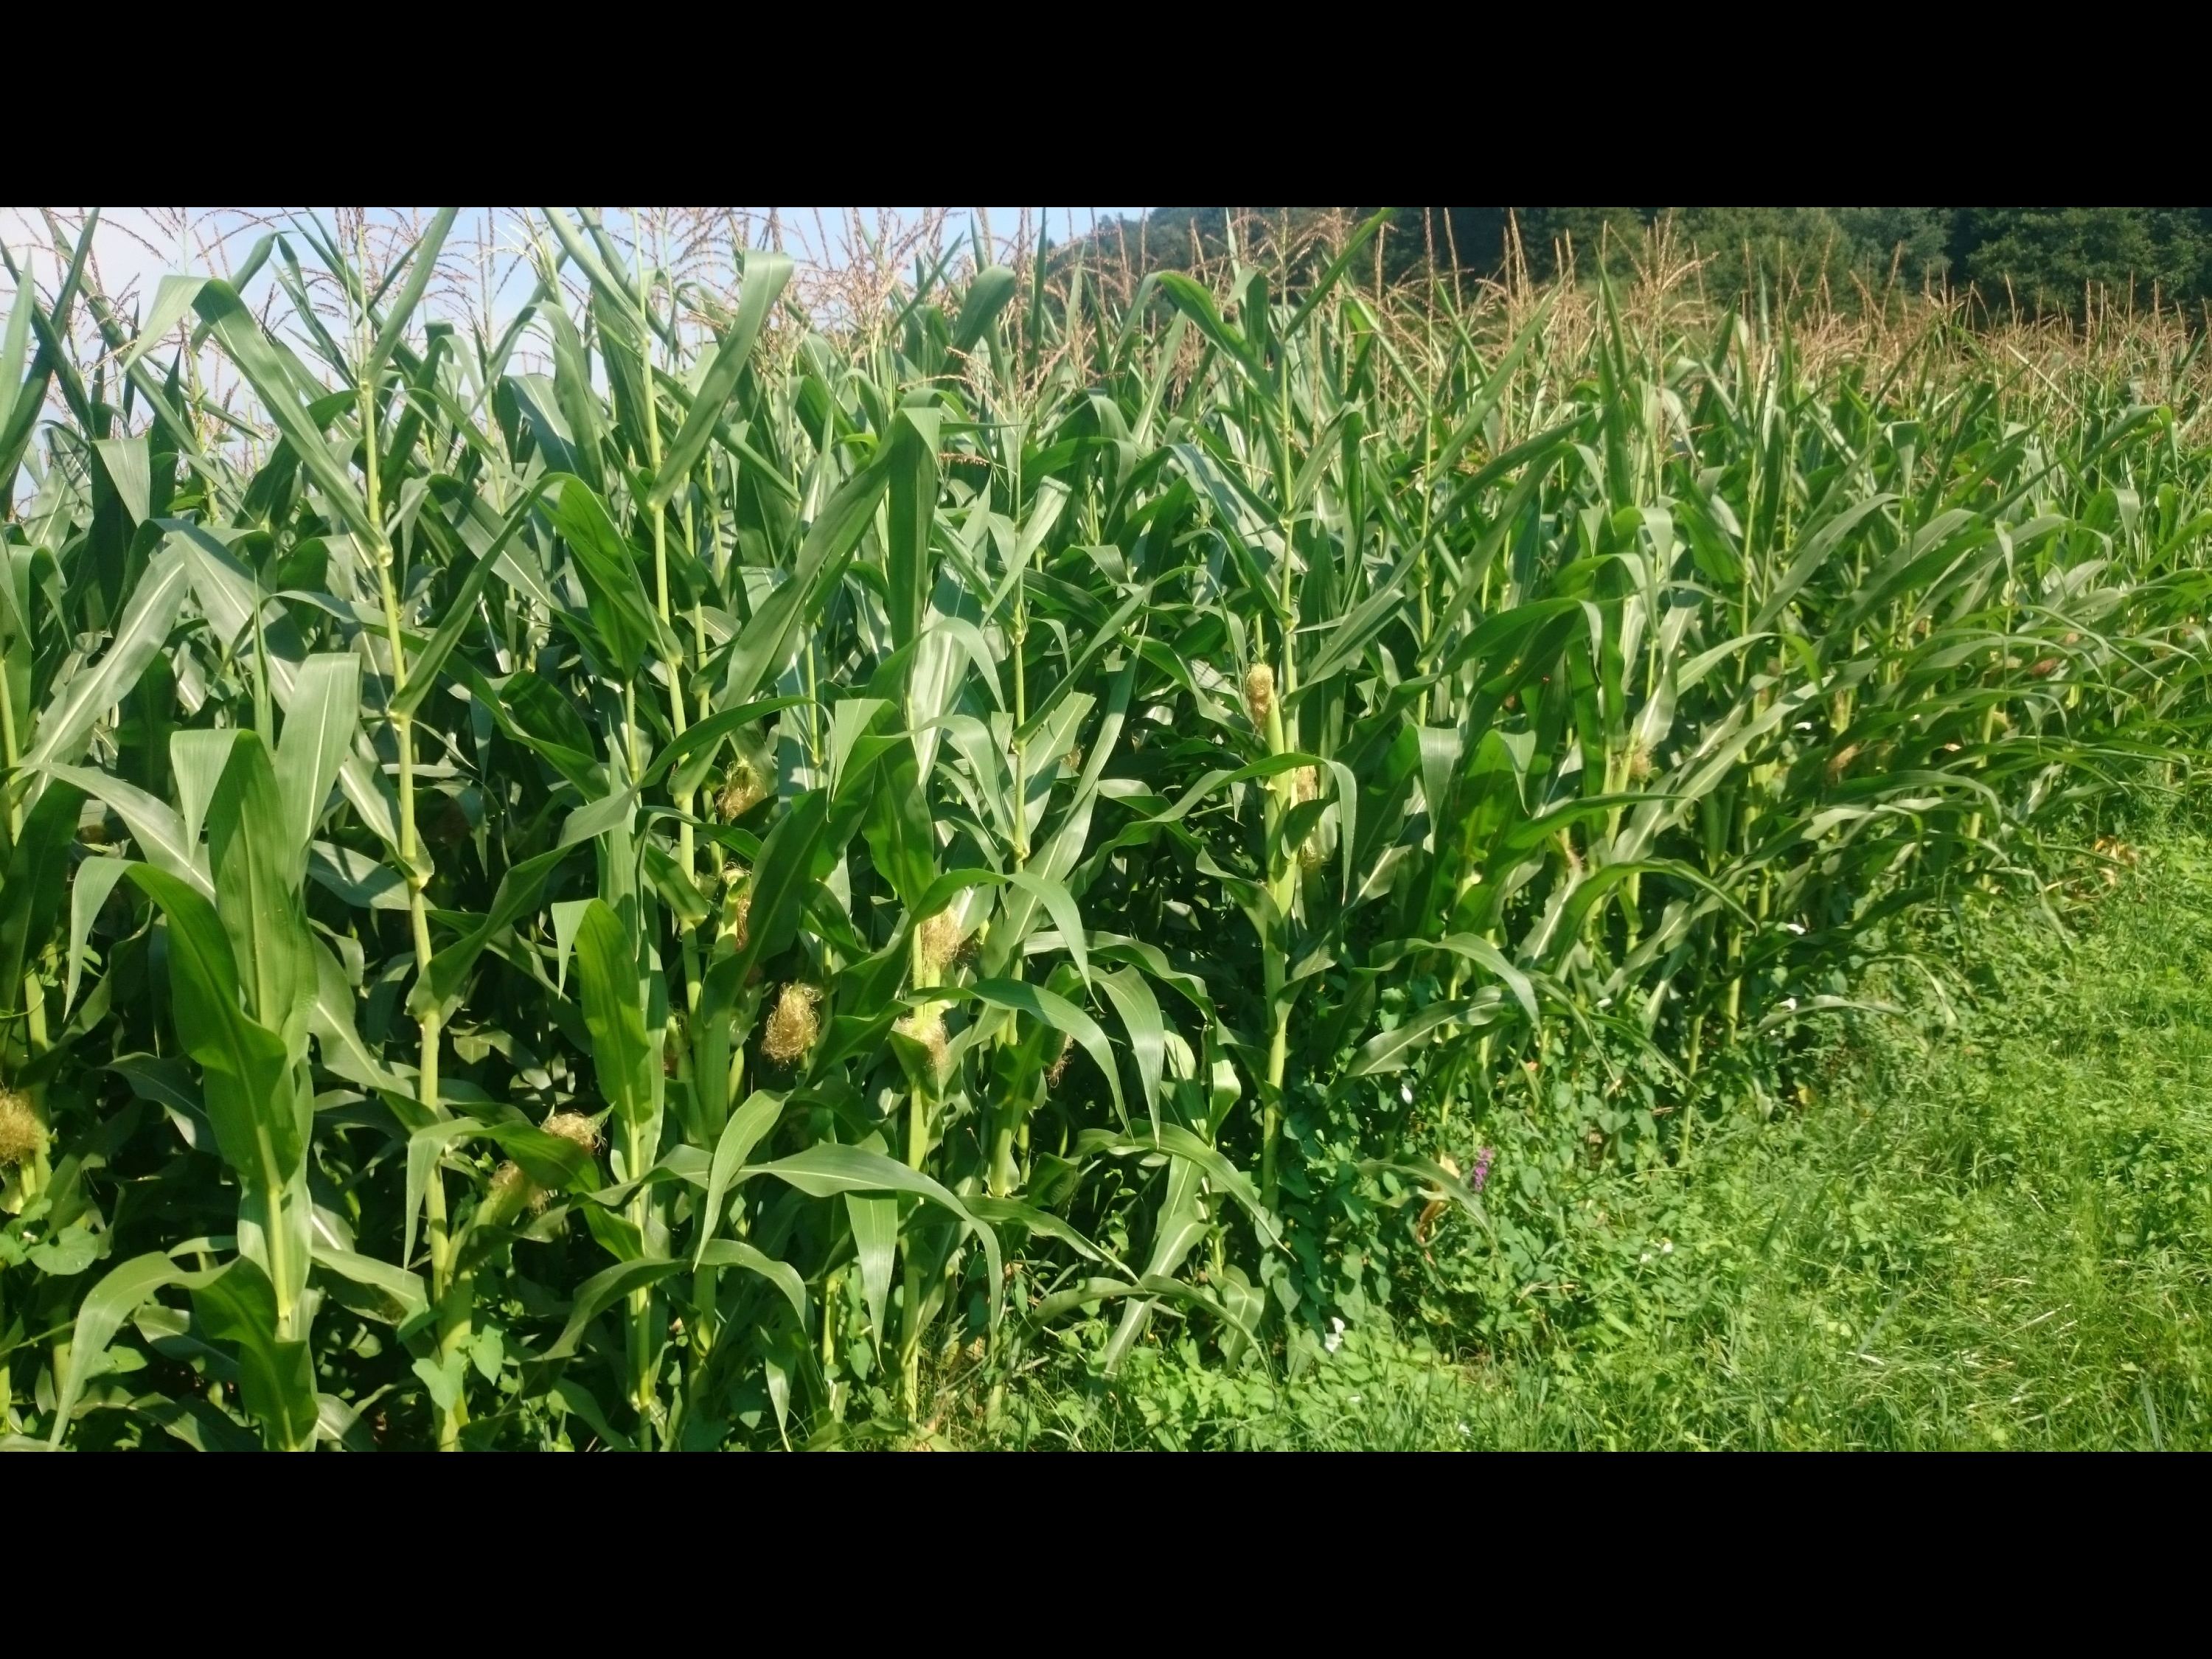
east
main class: Cropland
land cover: Maize
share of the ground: > 75 %
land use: Agriculture (excluding fallow land and kitchen gardens)
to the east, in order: Maize; Grass margins; Maize; Grass margins; Ditches and canals; Grass margins; Maize; Temporary grasslands; Common wheat
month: July
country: AT
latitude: 47.0320
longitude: 15.9884
